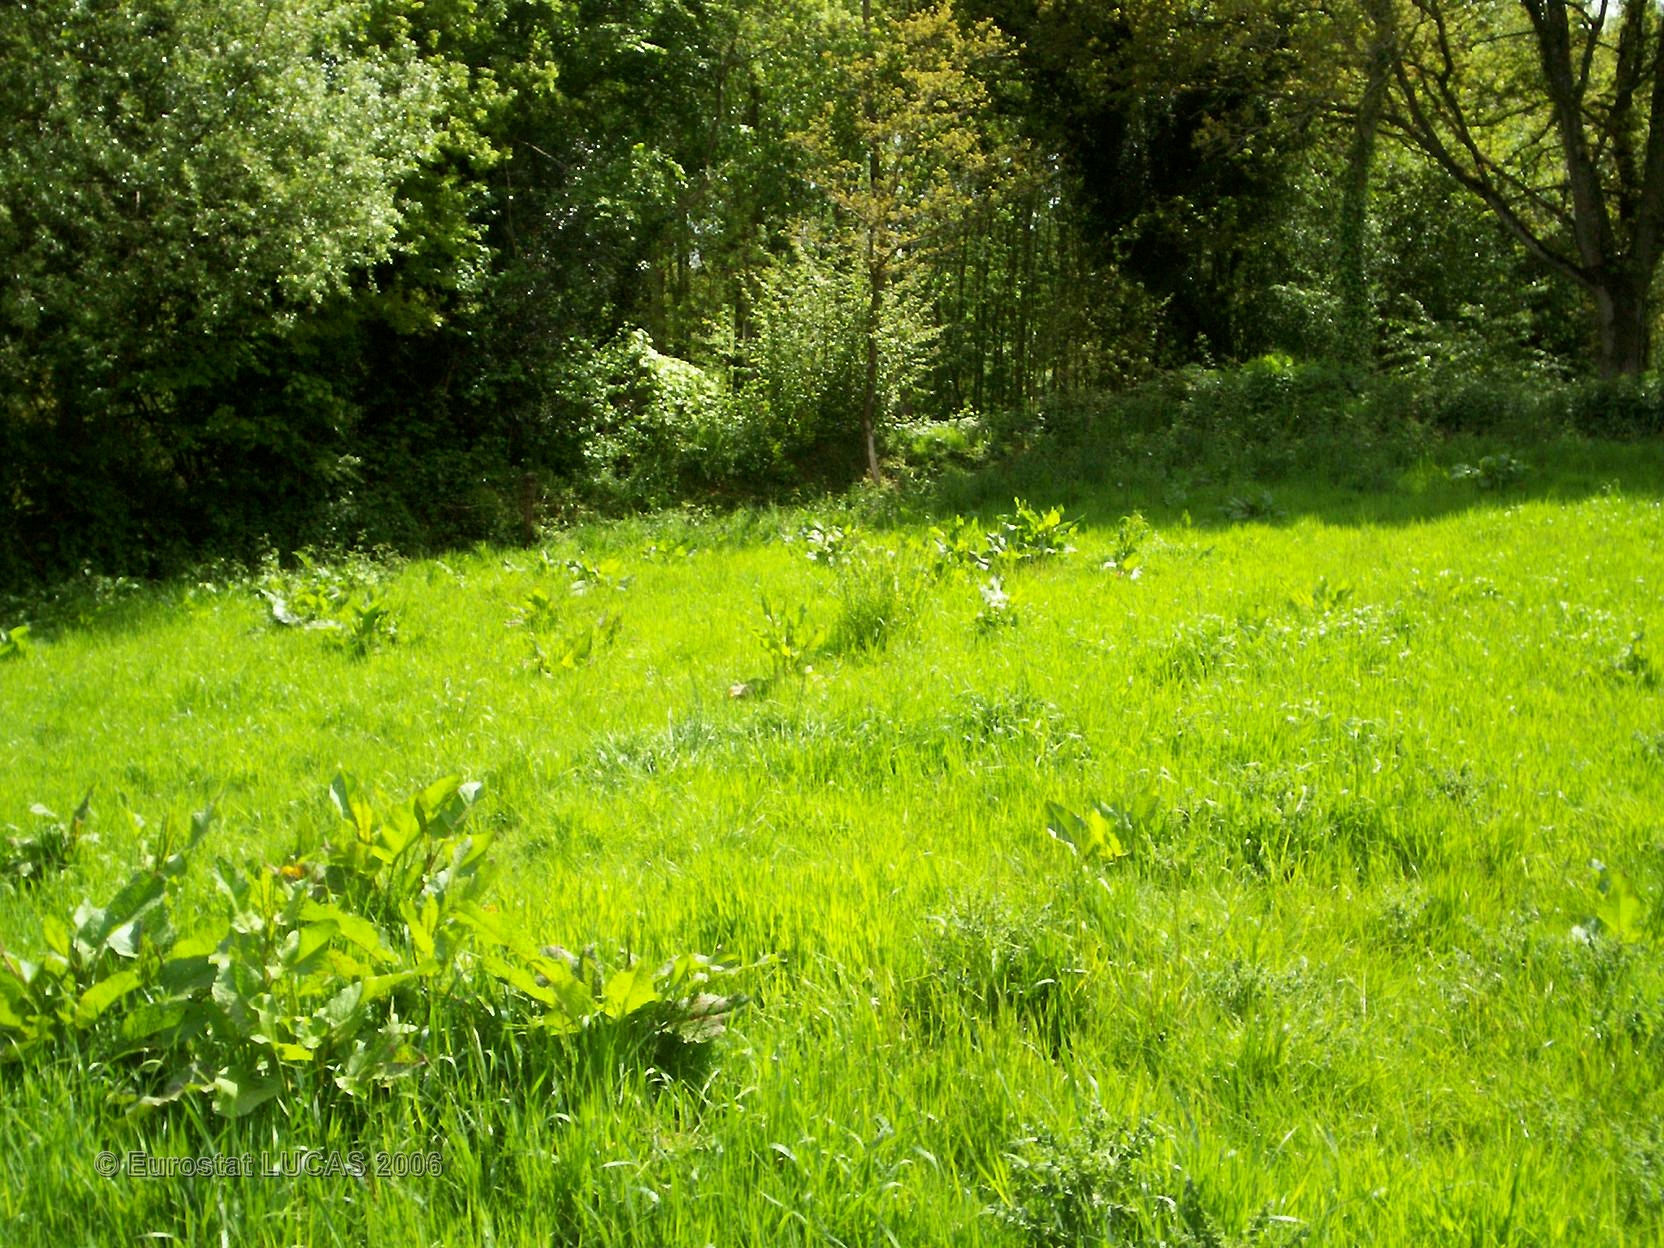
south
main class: Grassland
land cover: Grassland without tree/shrub cover
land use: Agriculture (excluding fallow land and kitchen gardens)
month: May
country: FR
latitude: 48.3866
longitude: -2.9374
